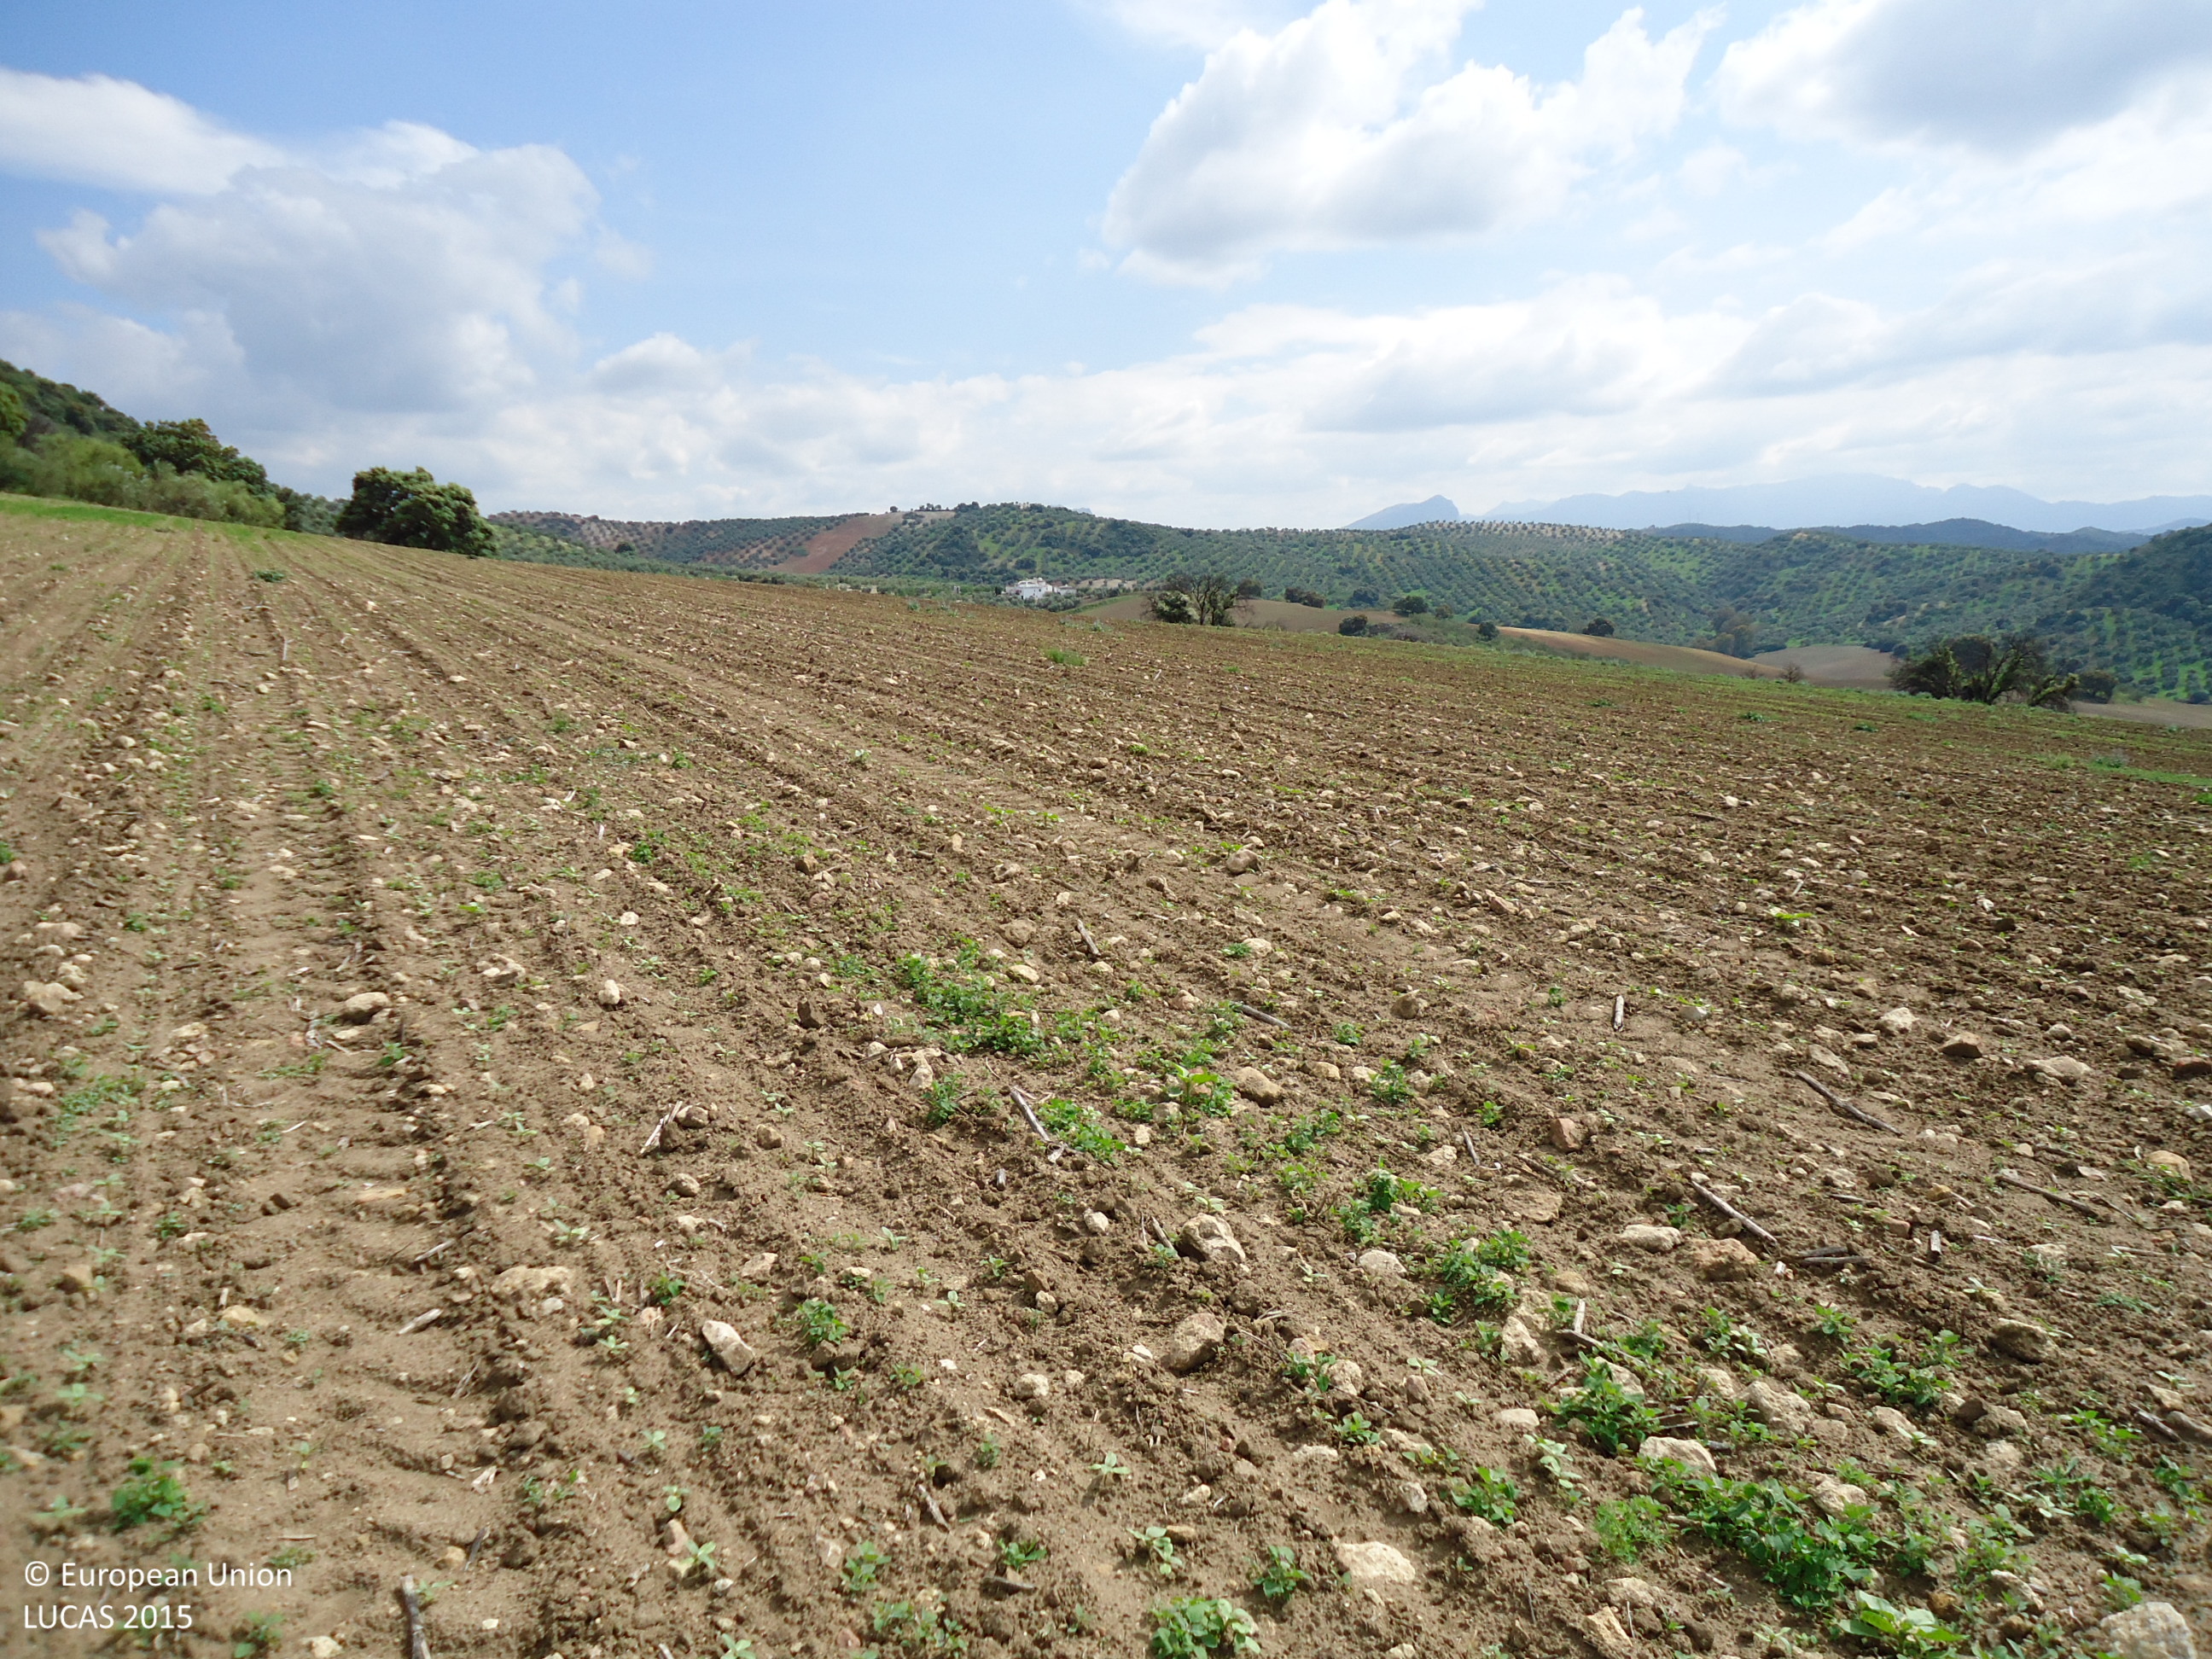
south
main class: Cropland
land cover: Sunflower
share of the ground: < 10 %
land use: Agriculture (excluding fallow land and kitchen gardens)
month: April
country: ES
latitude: 36.9811
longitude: -5.2952
